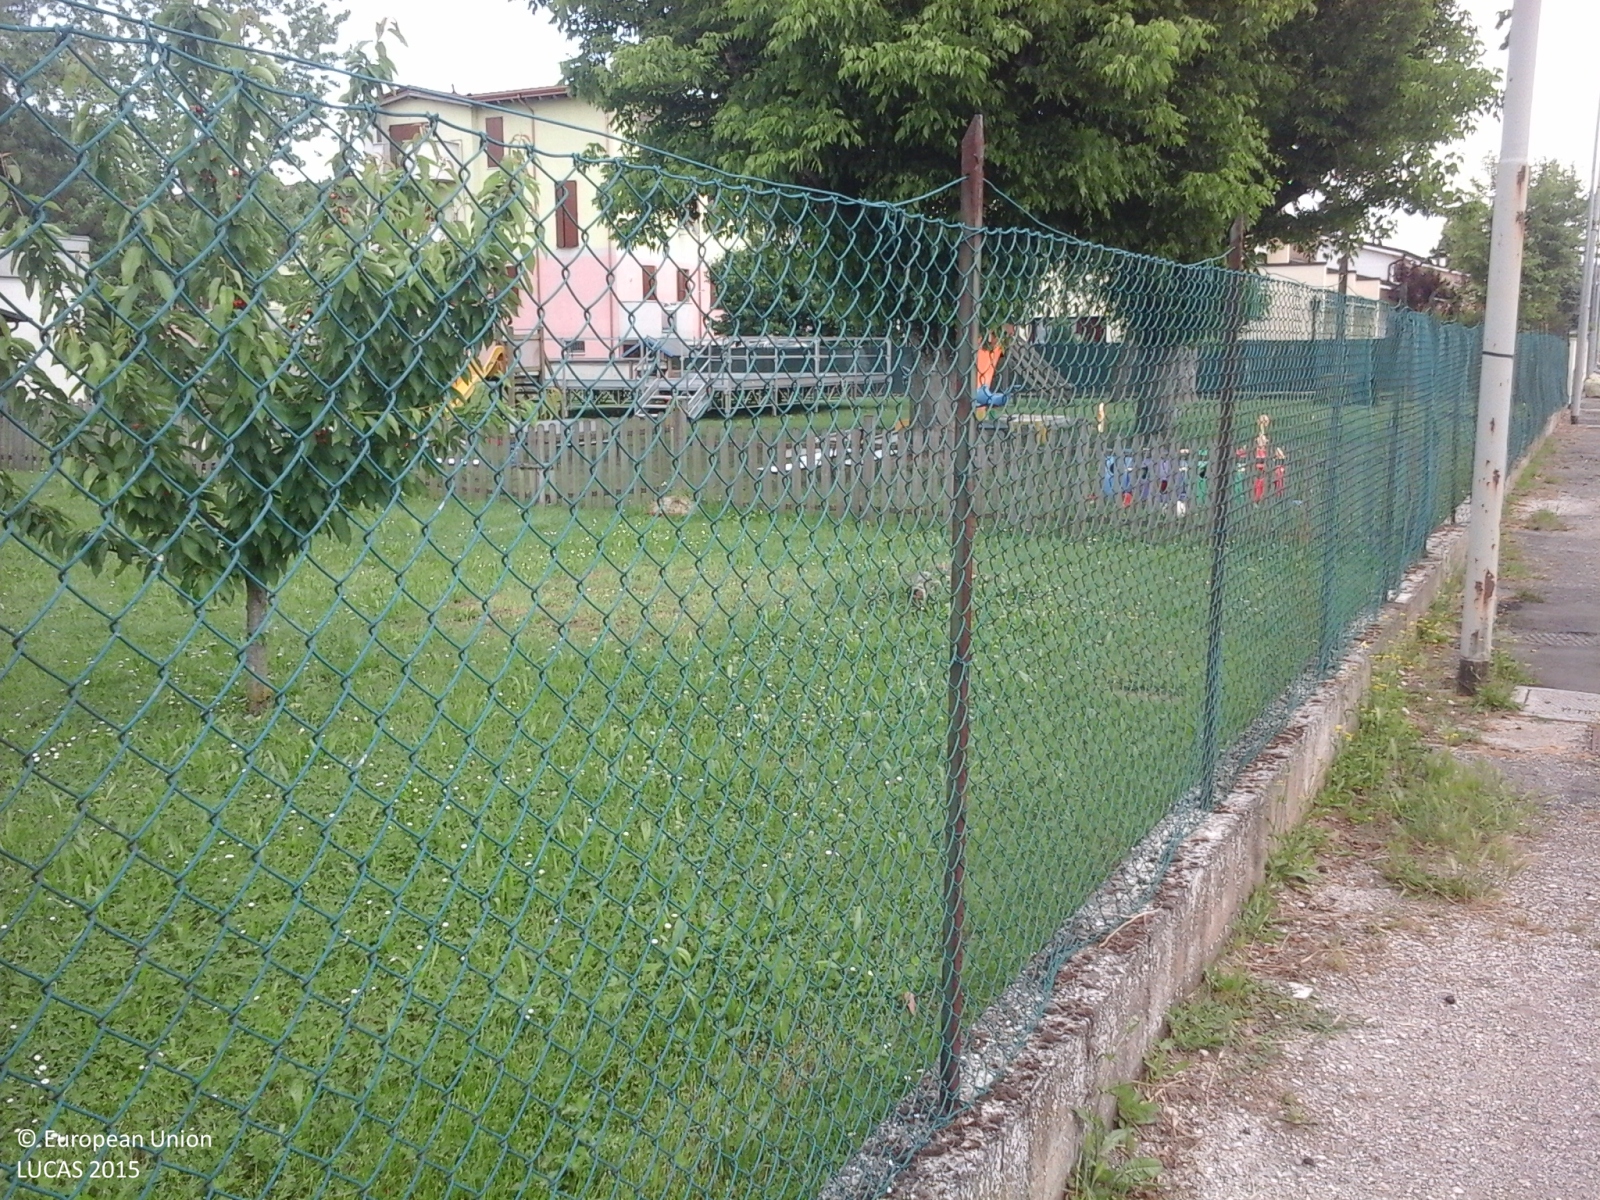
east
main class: Grassland
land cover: Grassland without tree/shrub cover
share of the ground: > 75 %
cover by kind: herbaceous plants 100 %
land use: Community services
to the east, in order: Fences; Grassland without tree/shrub cover; Artificial constructions in urban areas
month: May
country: IT
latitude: 45.0511
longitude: 10.7477
